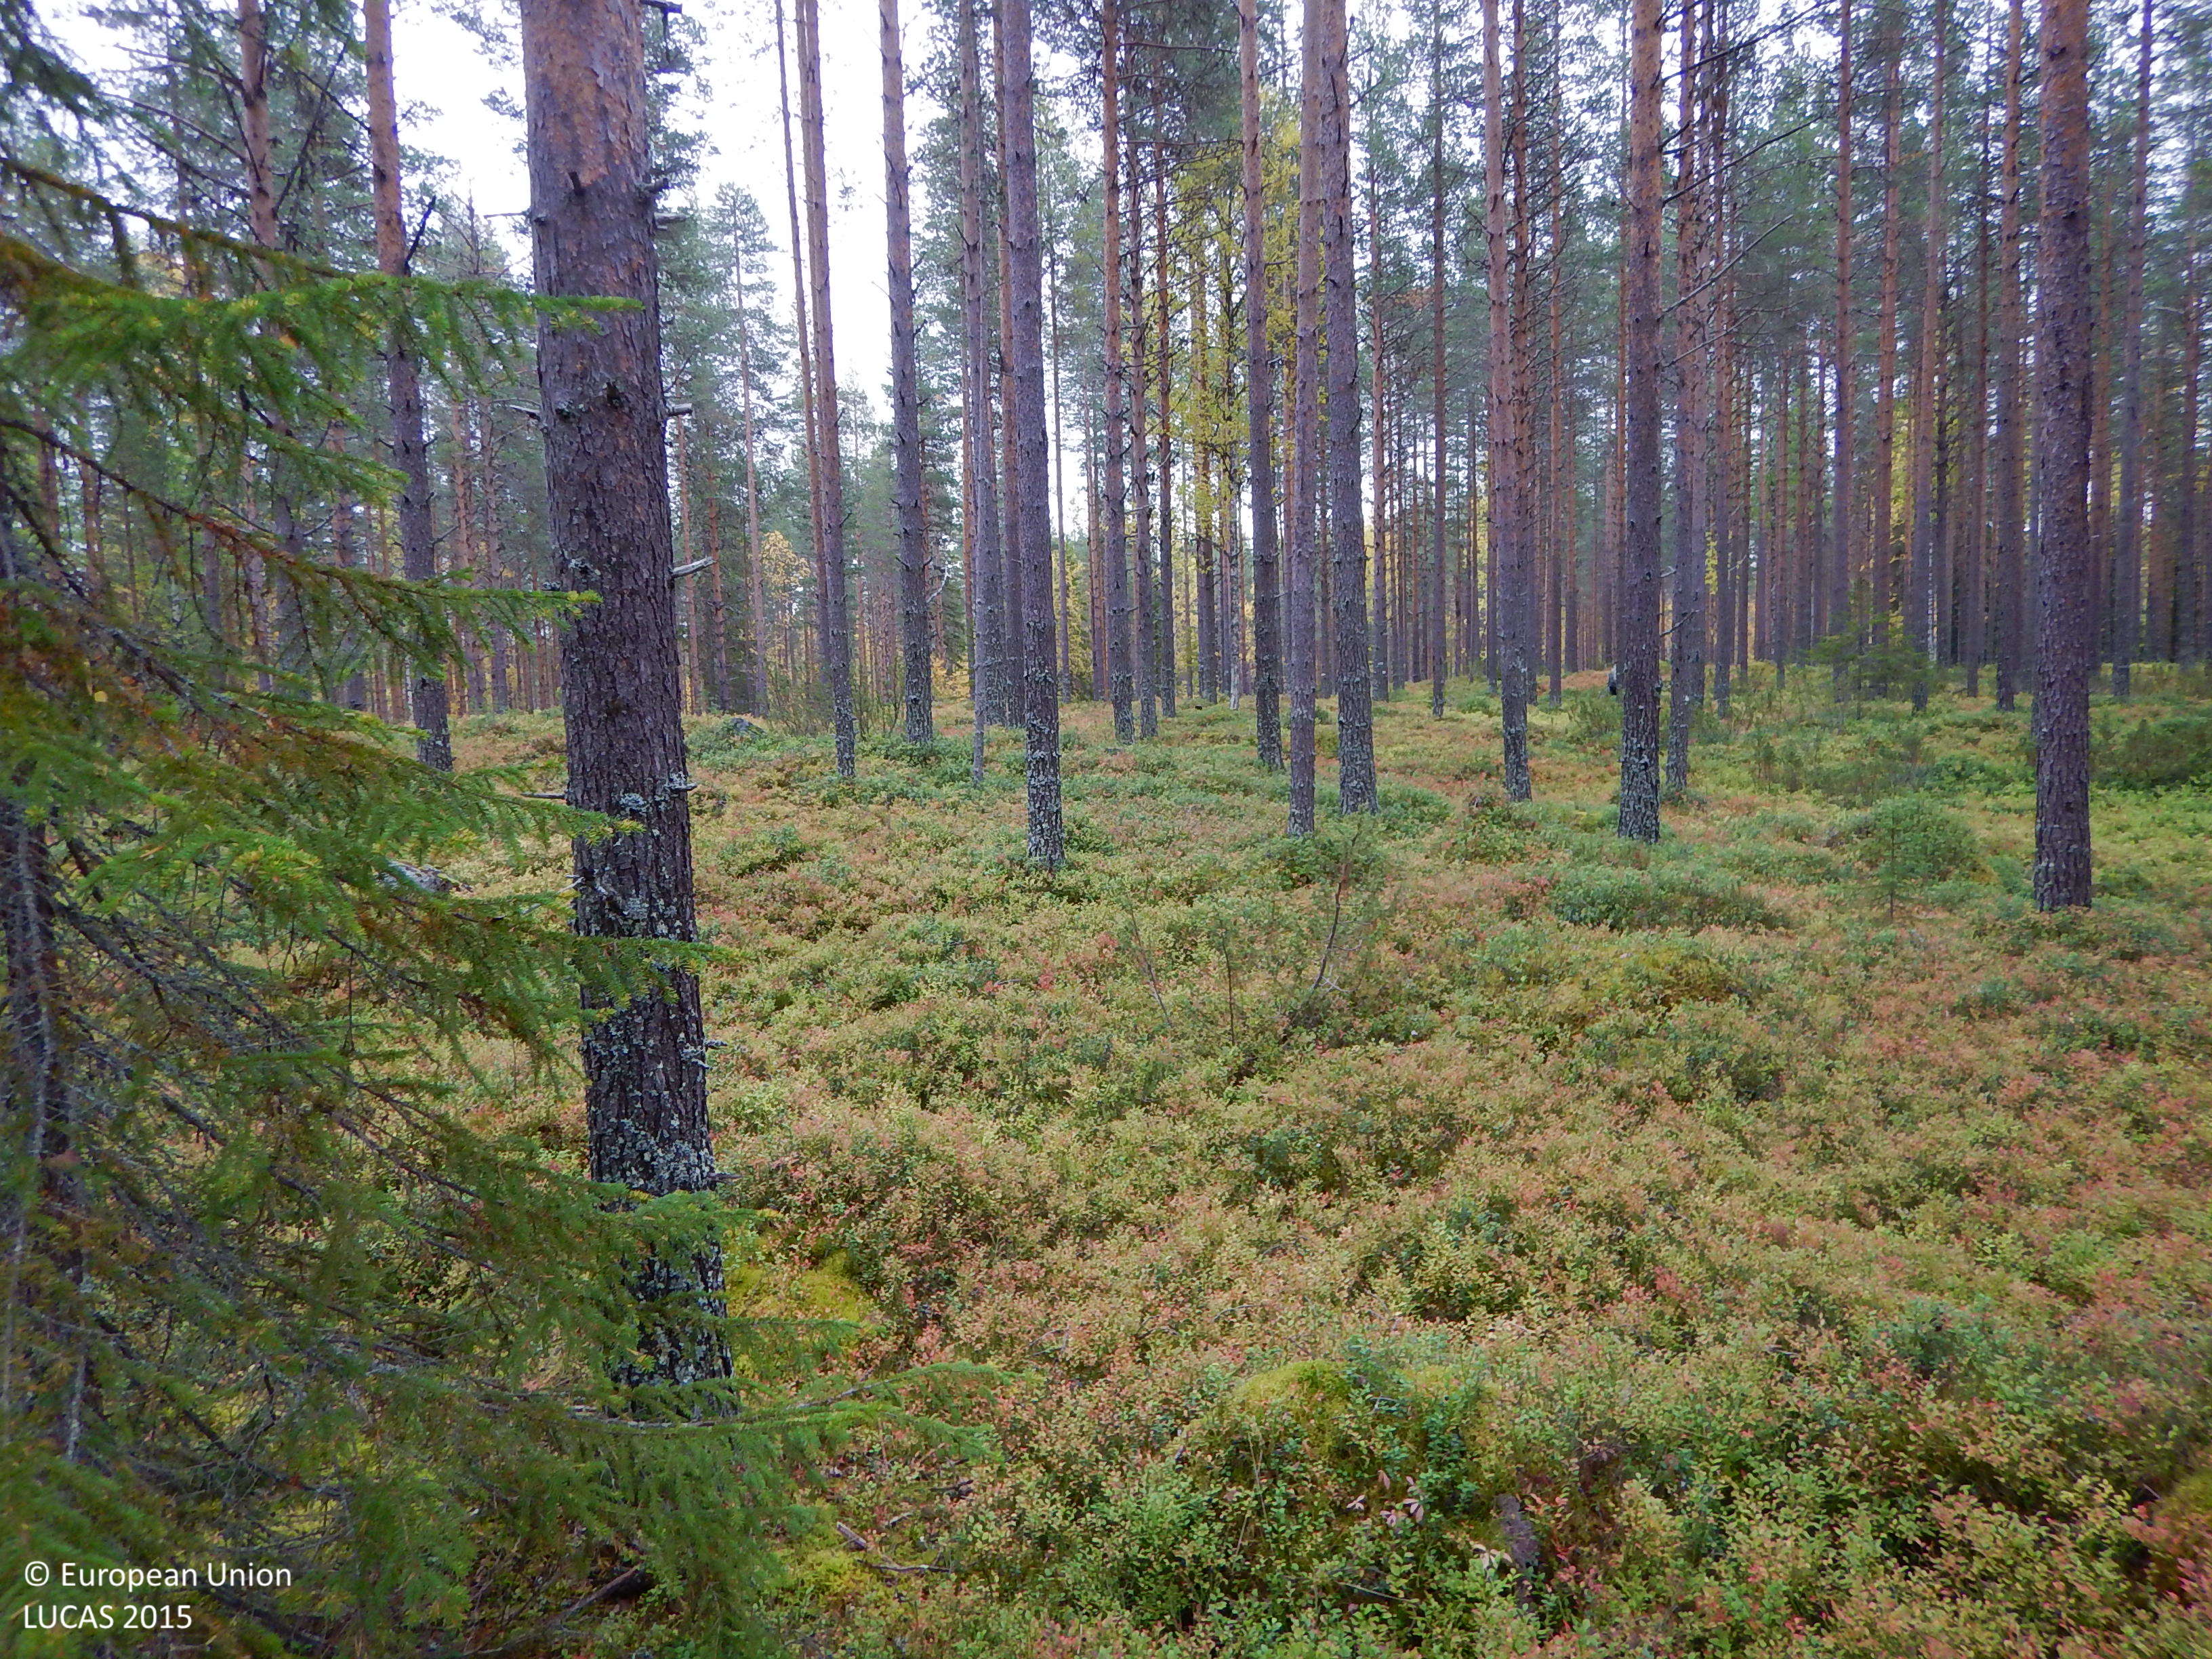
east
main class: Woodland
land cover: Pine dominated coniferous woodland
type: boreal forest
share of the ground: 50 - 75 %
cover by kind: coniferous forest trees 60 %, shrubs 20 %, lichens and mosses 15 %, broadleaved forest trees 5 %
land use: Forestry
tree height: > 5 m
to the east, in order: Pine dominated coniferous woodland; Rivers and streams; Pine dominated coniferous woodland
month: September
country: SE
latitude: 65.1374
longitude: 19.1091
